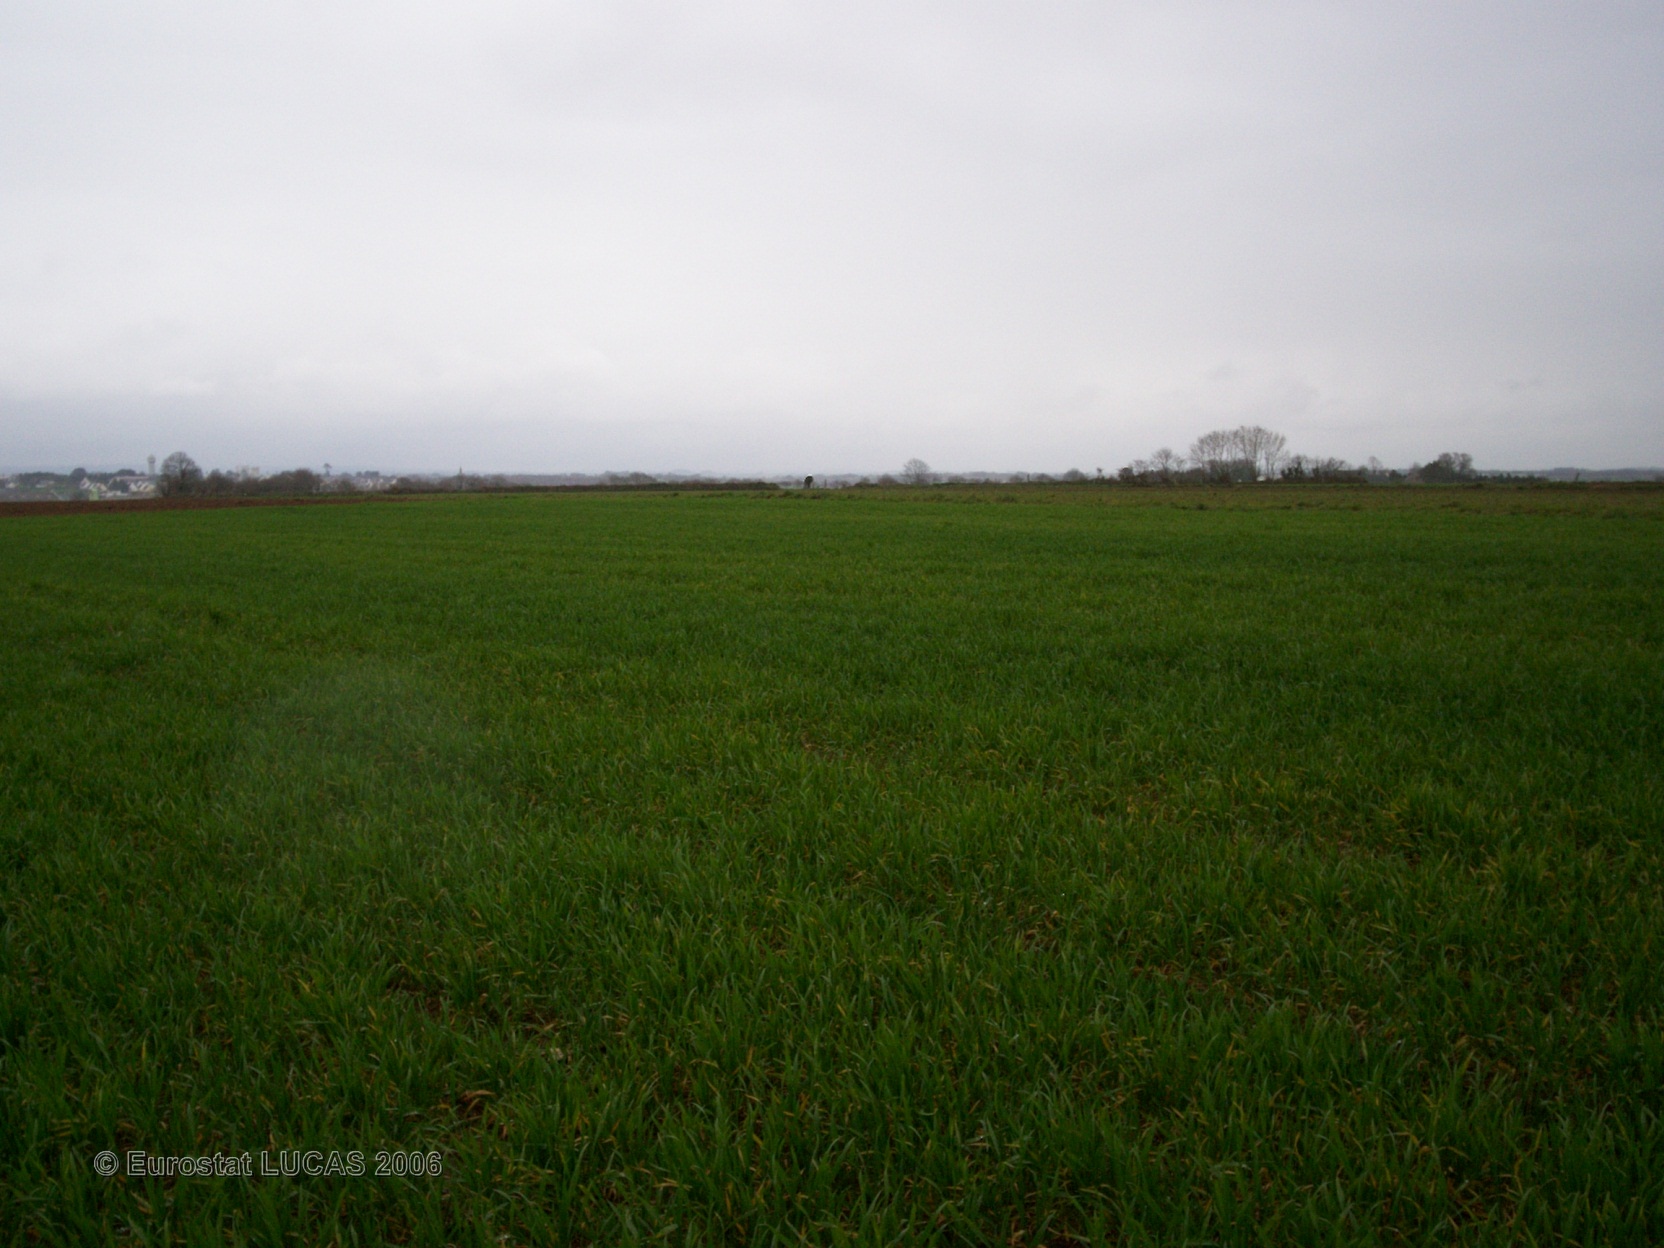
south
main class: Cropland
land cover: Common wheat
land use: Agriculture (excluding fallow land and kitchen gardens)
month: April
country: FR
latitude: 48.5371
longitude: -3.9428
